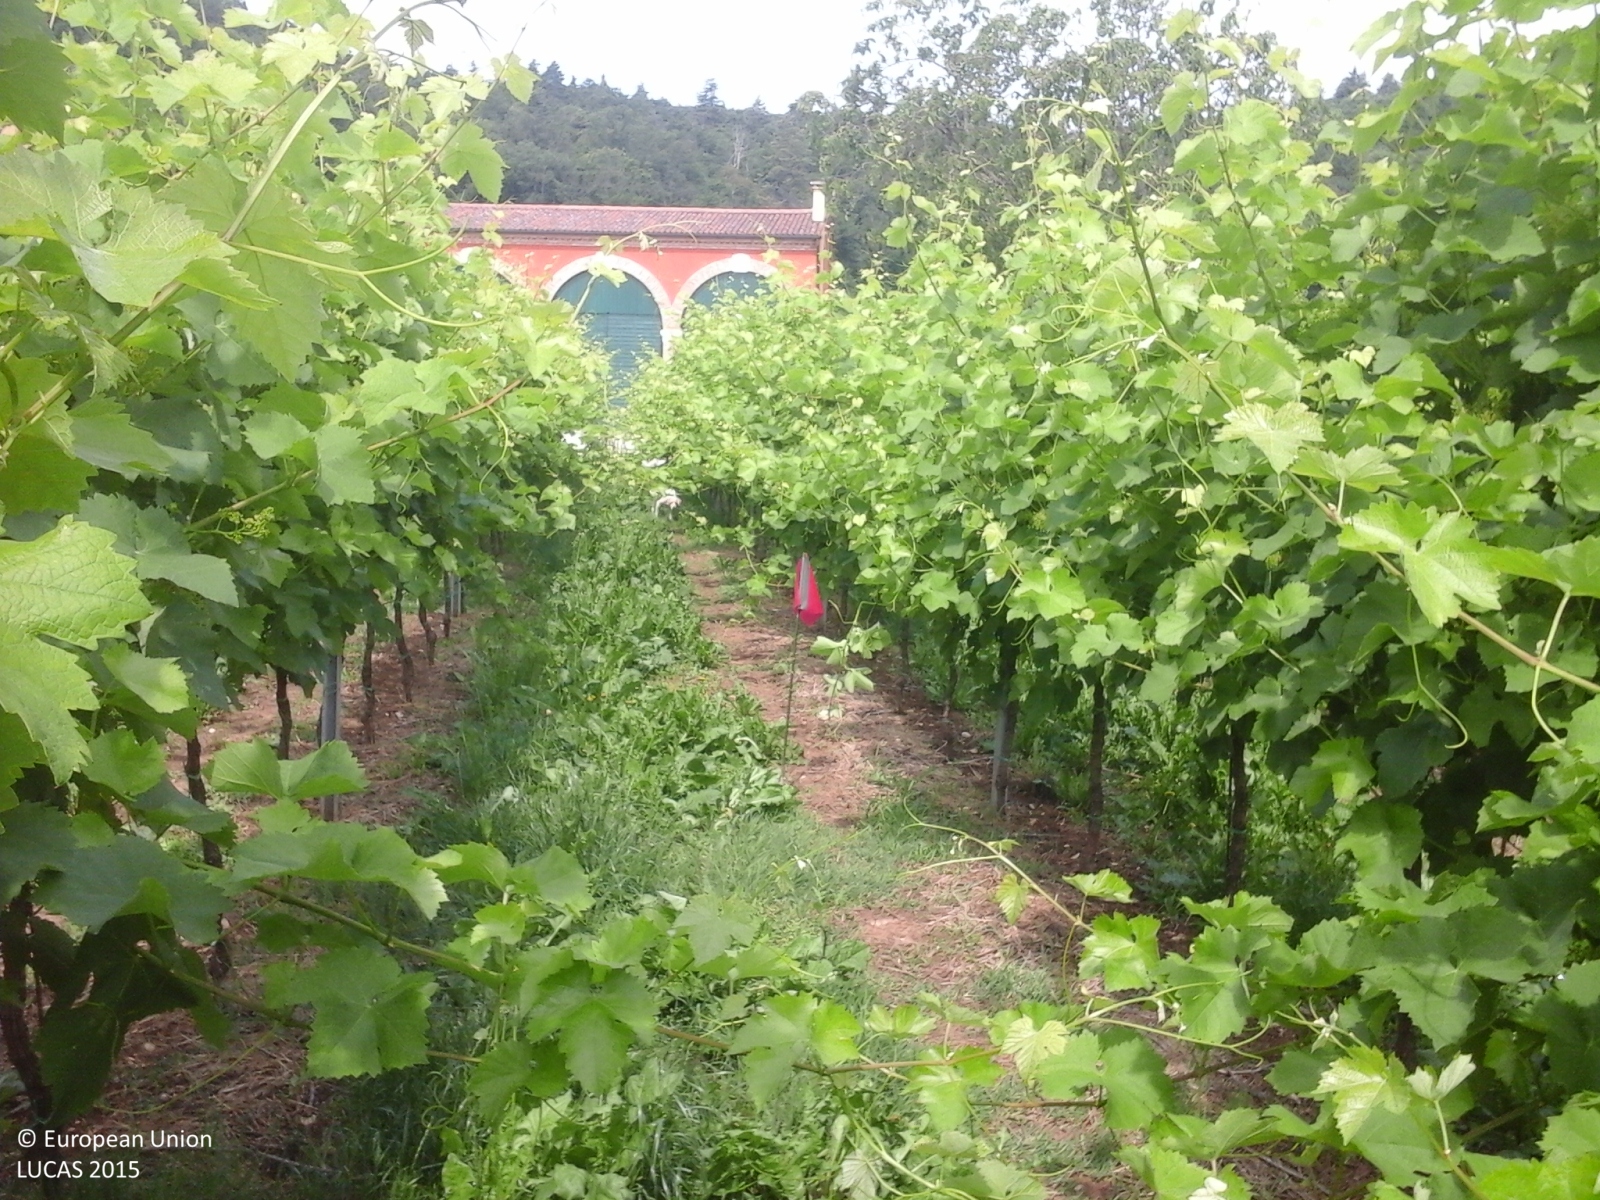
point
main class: Cropland
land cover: Vineyards
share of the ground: > 75 %
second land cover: Grassland without tree/shrub cover
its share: 50 - 75 %
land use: Agriculture (excluding fallow land and kitchen gardens)
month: May
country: IT
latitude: 45.4026
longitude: 11.5687
